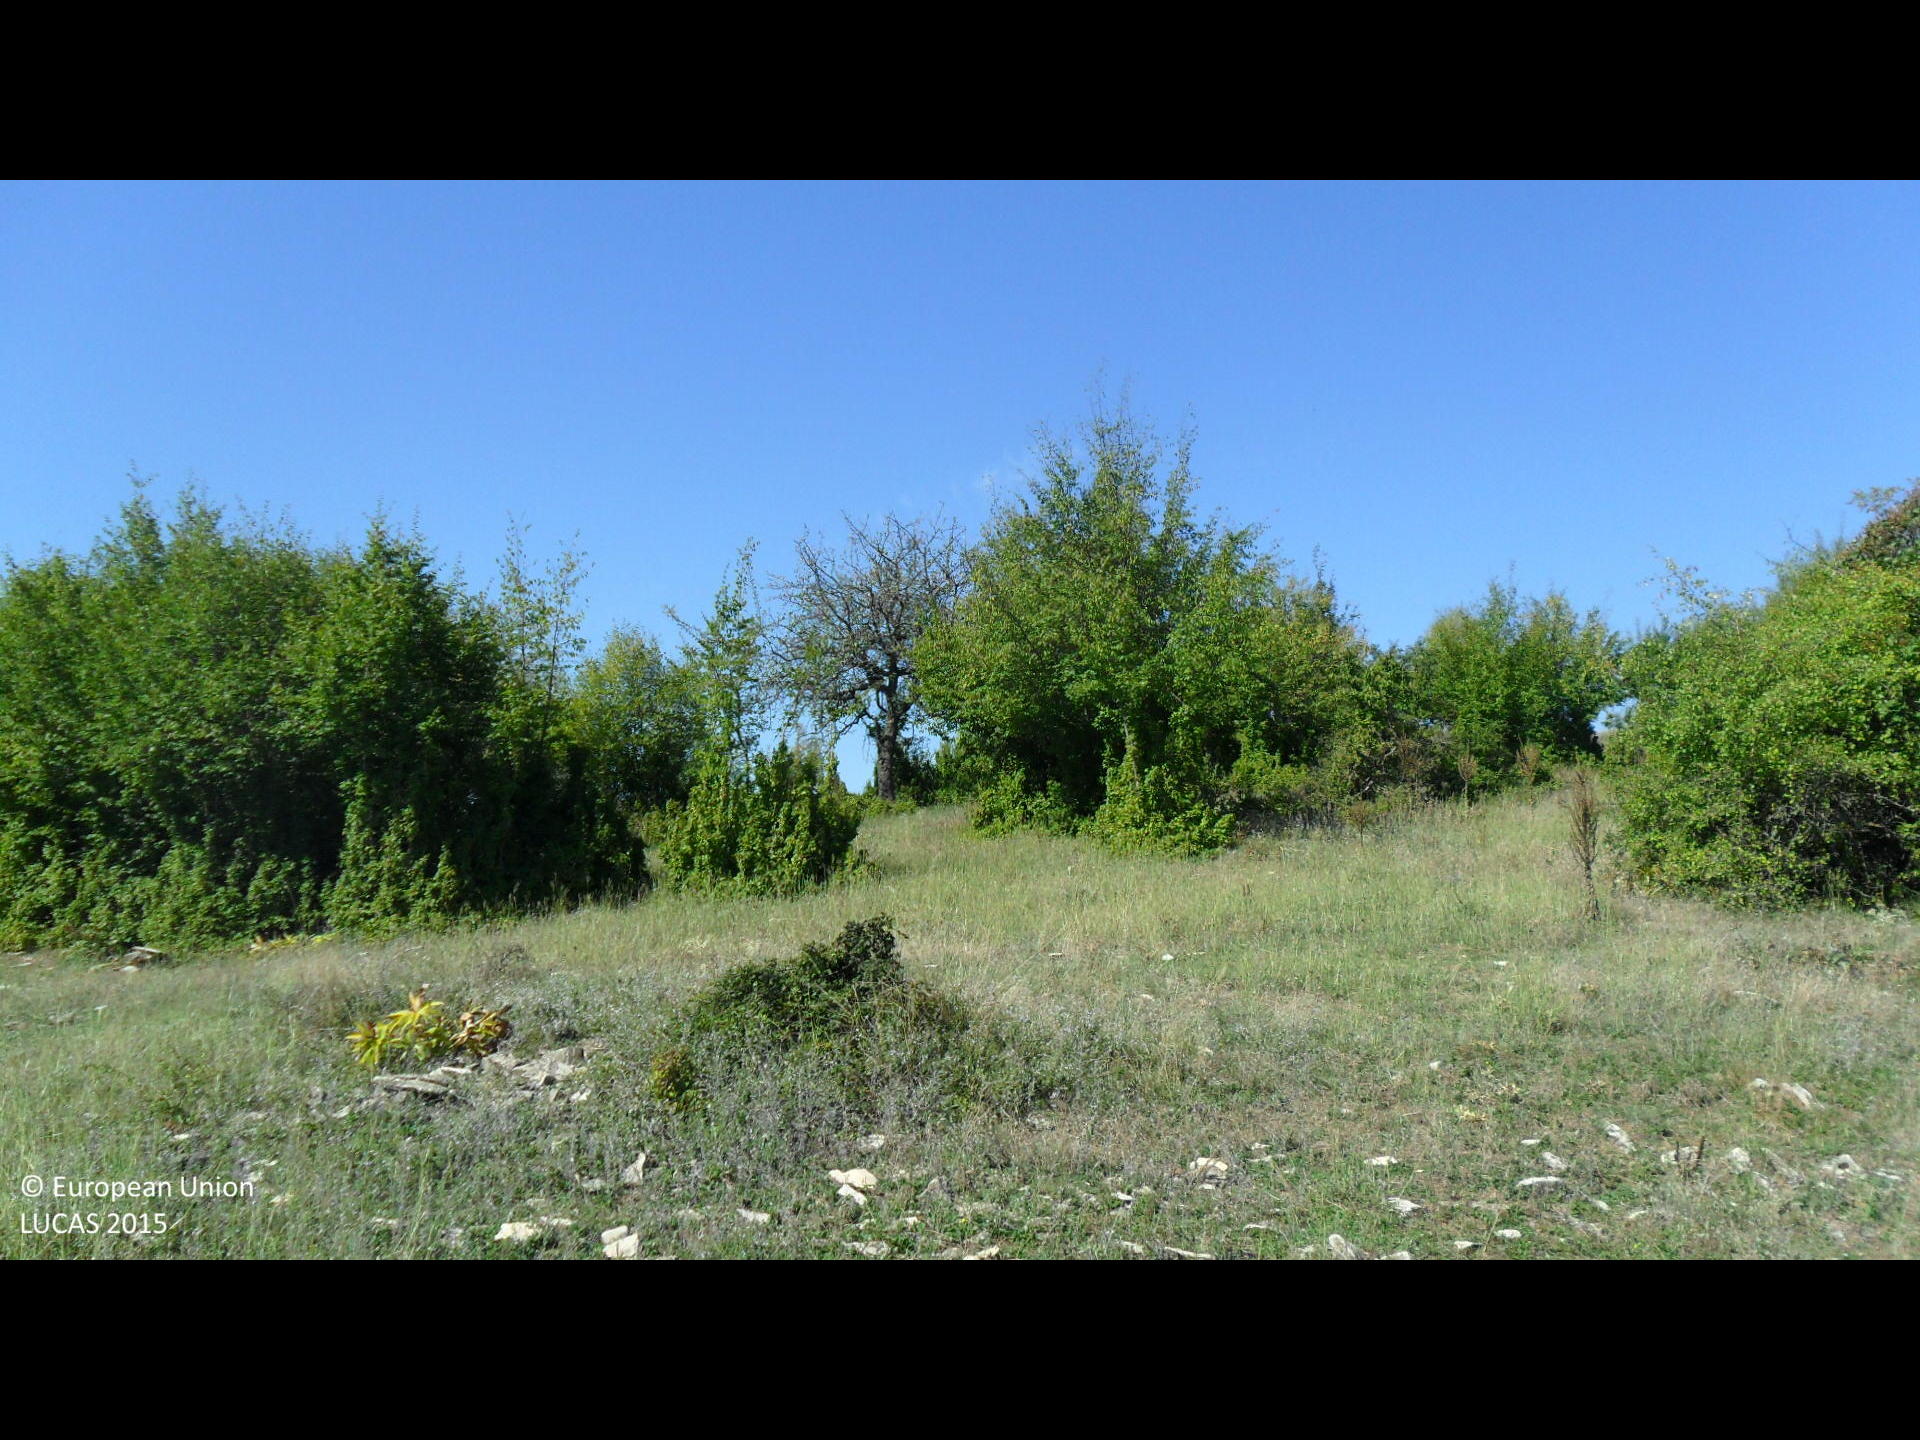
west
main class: Grassland
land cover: Grassland with sparse tree/shrub cover
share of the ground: > 75 %
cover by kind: herbaceous plants 90 %, broadleaved forest trees 5 %, shrubs 5 %
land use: Agriculture (excluding fallow land and kitchen gardens)
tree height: > 5 m
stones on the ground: 25 - 50 %
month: September
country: BG
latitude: 43.2053
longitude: 26.4824
